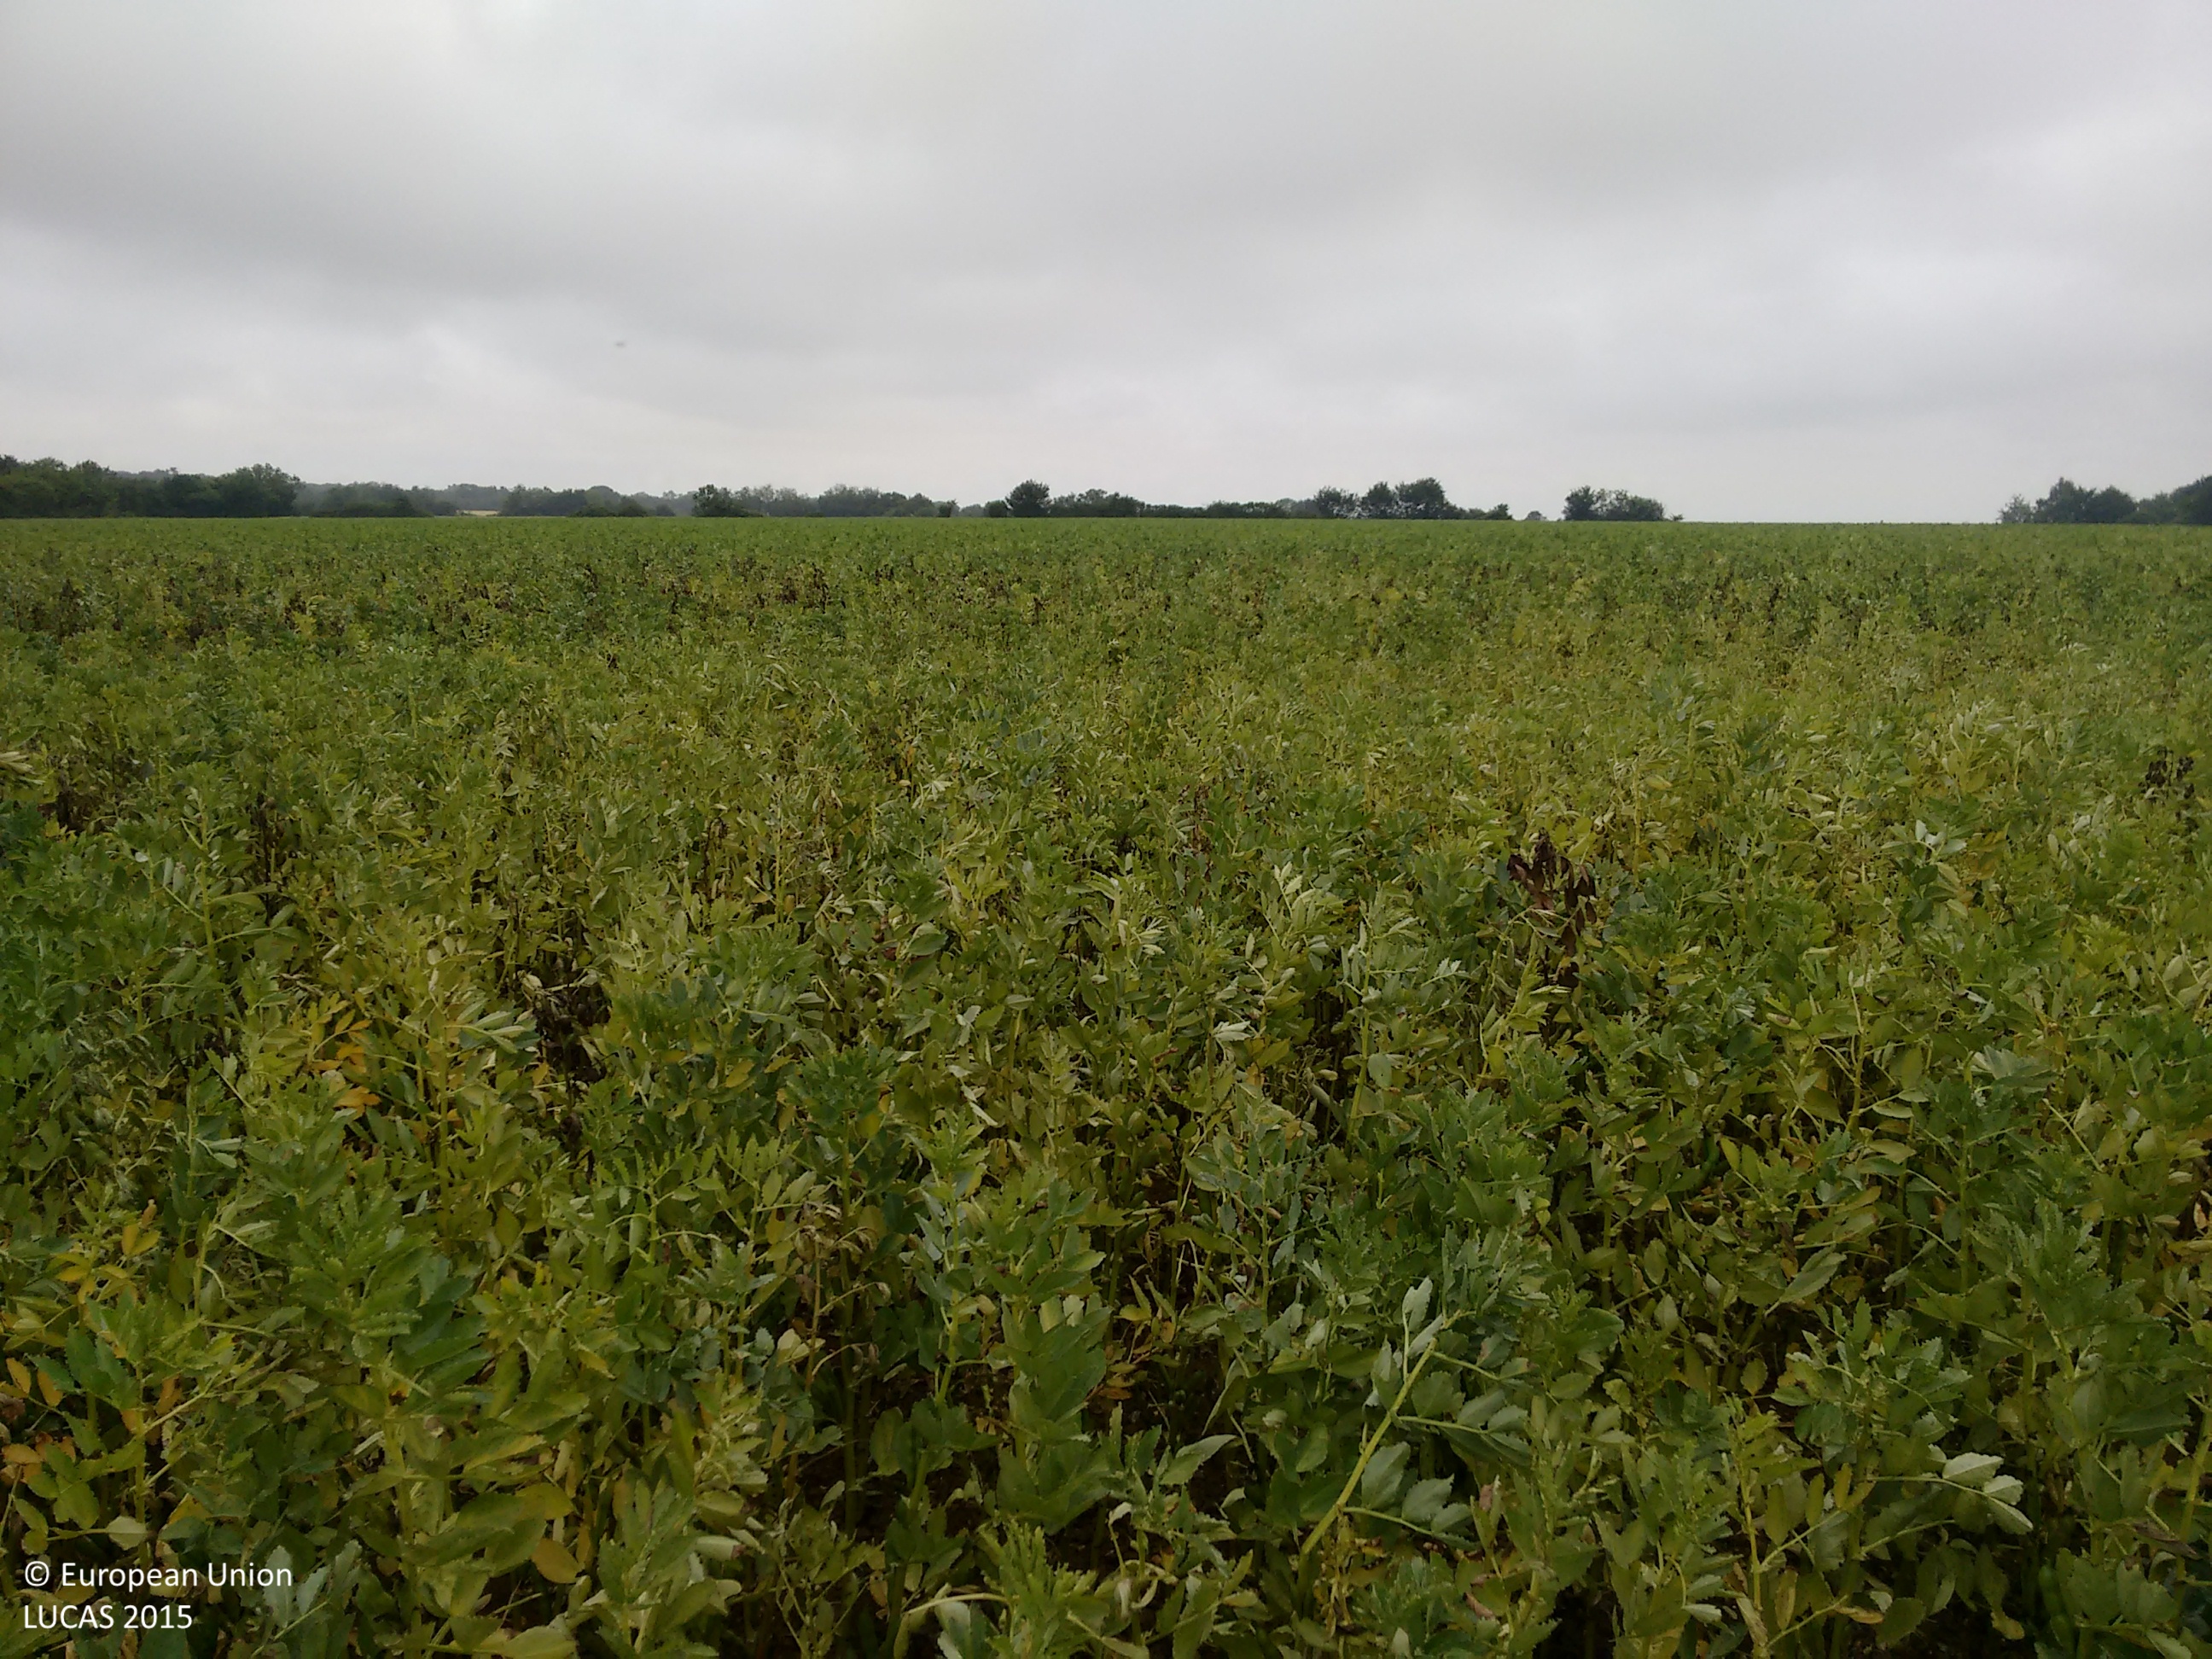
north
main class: Cropland
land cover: Dry pulses
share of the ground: > 75 %
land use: Agriculture (excluding fallow land and kitchen gardens)
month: July
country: GB
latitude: 51.7827
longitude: 0.3310
